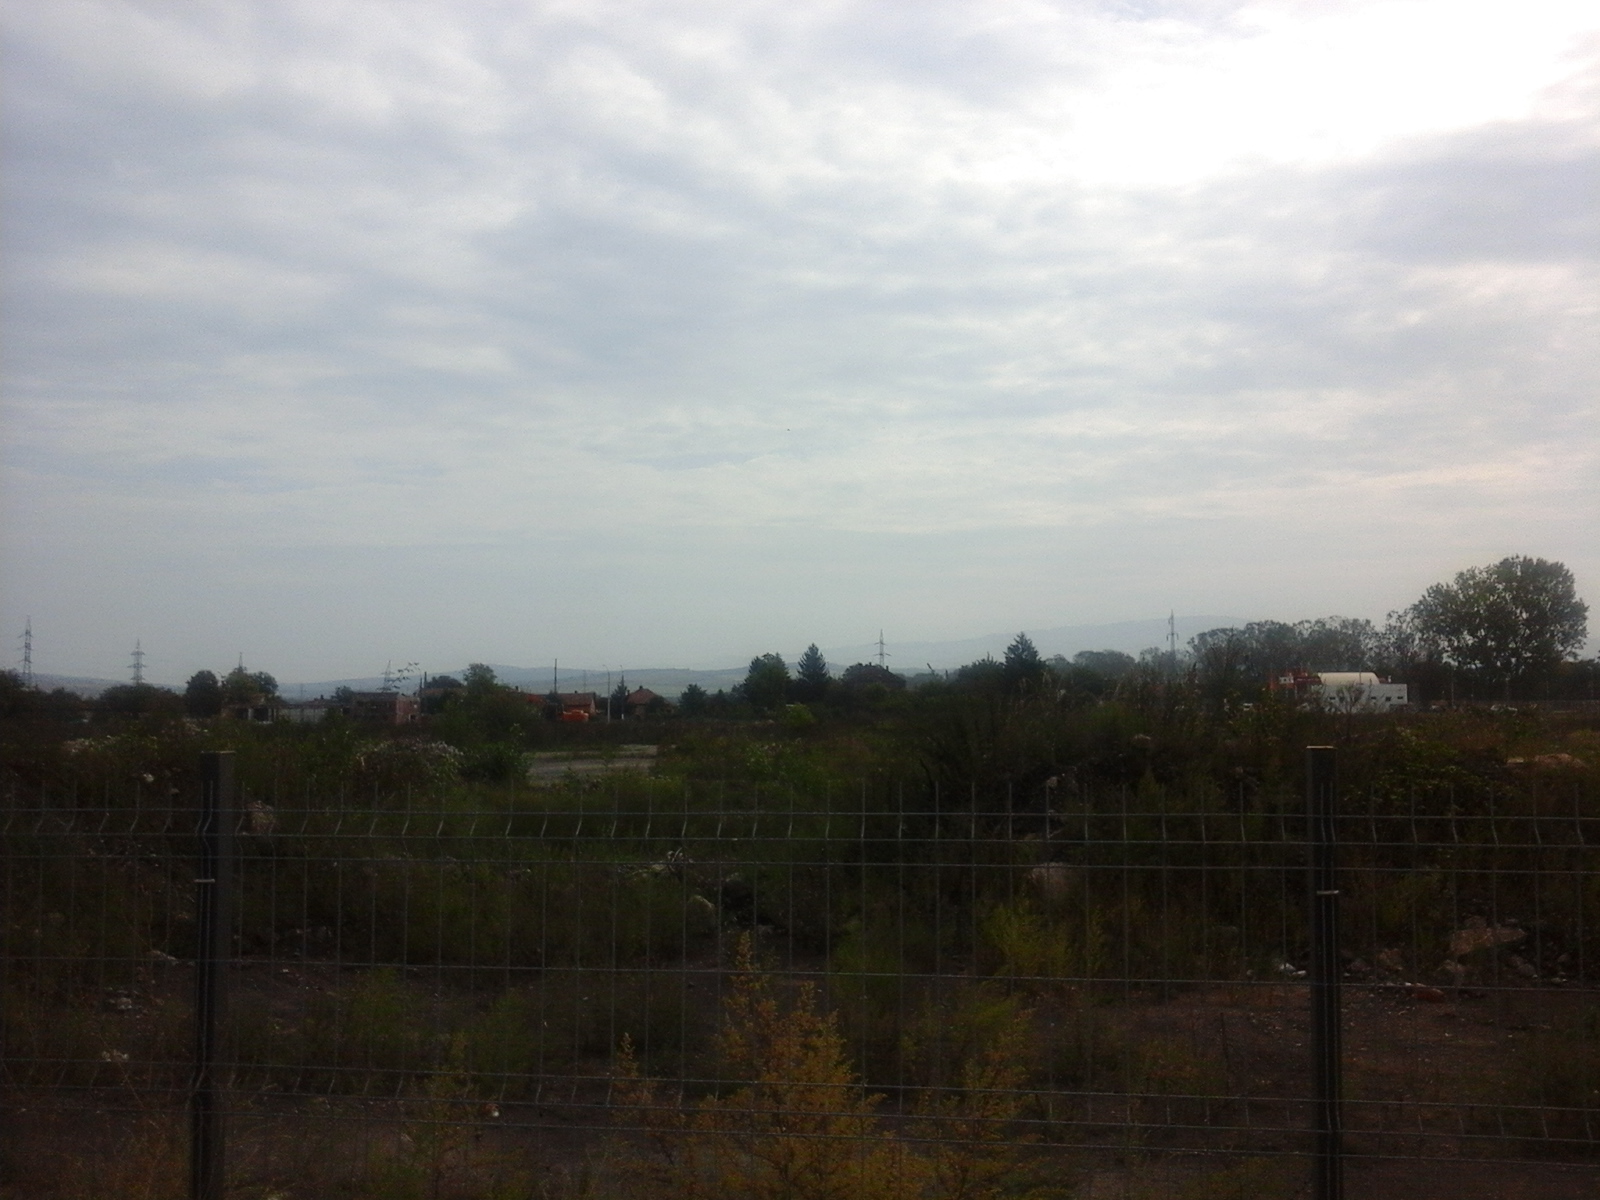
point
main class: Grassland
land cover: Spontaneously vegetated surfaces
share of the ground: > 75 %
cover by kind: herbaceous plants 100 %
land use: Agriculture (excluding fallow land and kitchen gardens)
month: September
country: RO
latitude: 45.7367
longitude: 22.9960
